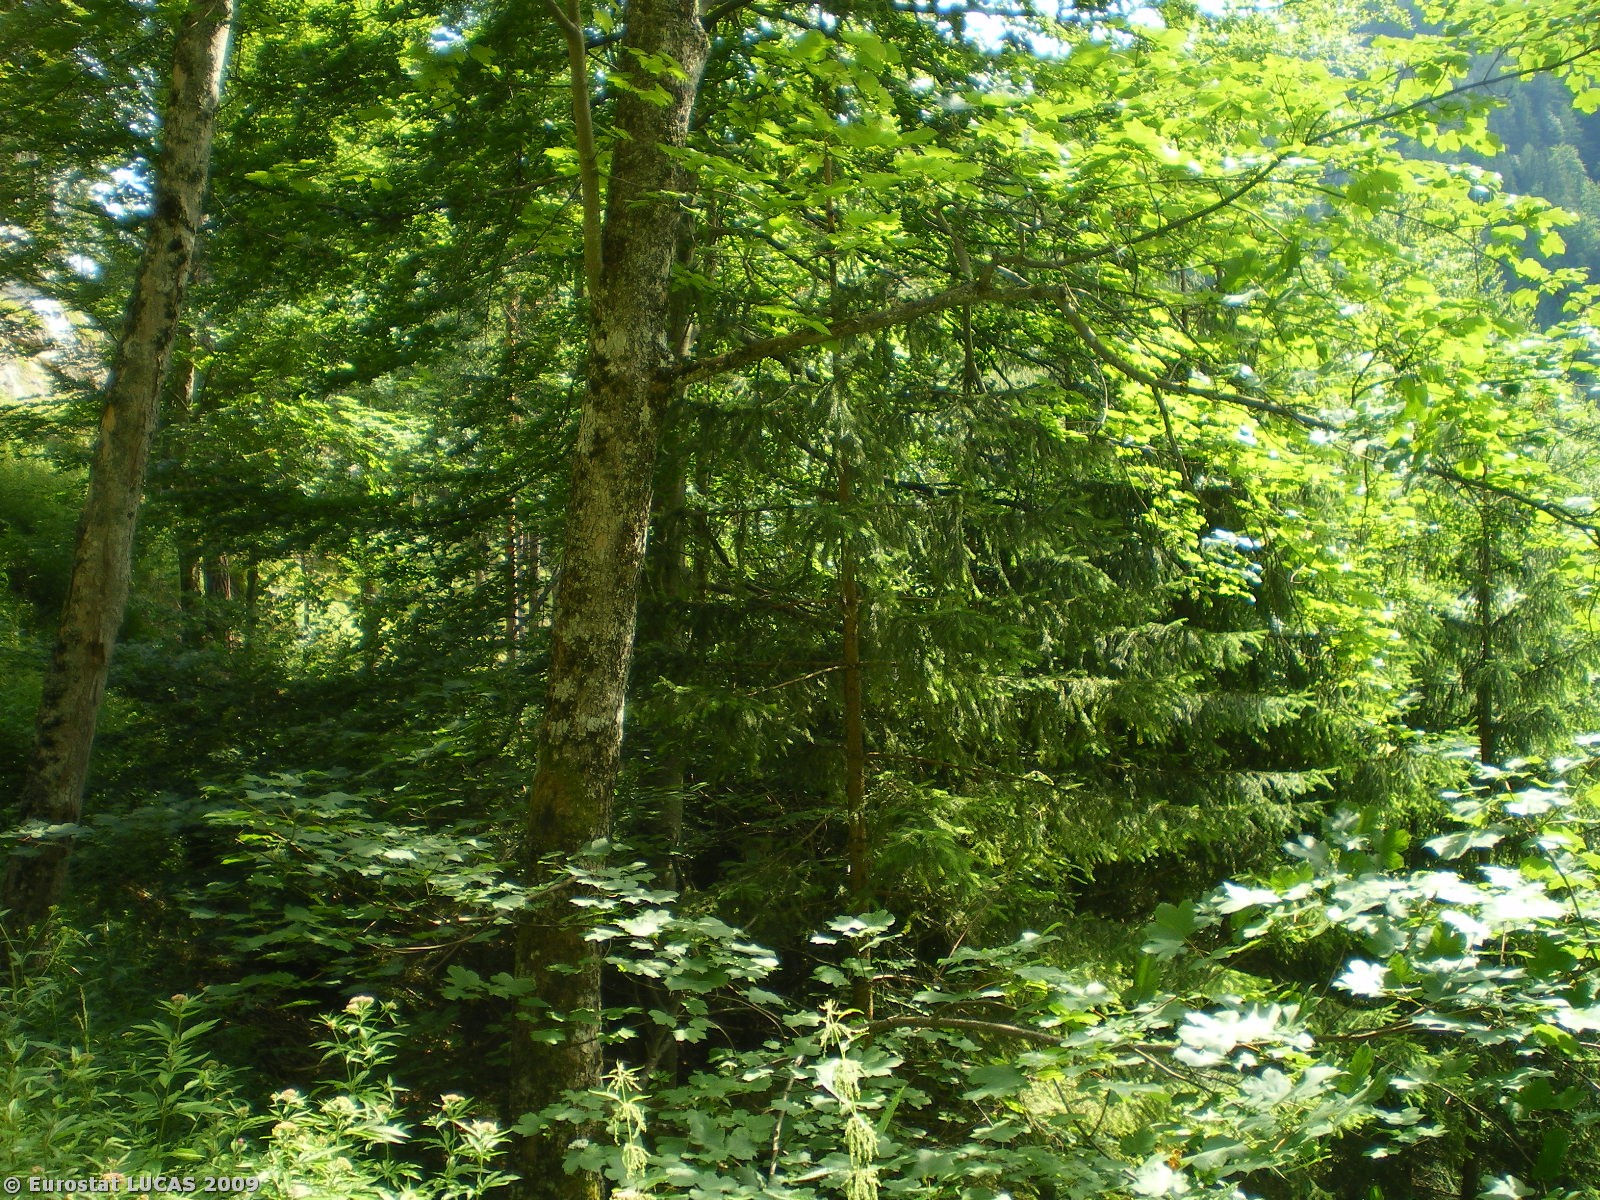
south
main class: Woodland
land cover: Mixed woodland
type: hemiboreal forest and nemoral coniferous forest and mixed broadleaved-coniferous forest
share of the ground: > 75 %
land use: Forestry
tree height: > 5 m
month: July
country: AT
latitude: 47.8605
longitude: 15.6830
